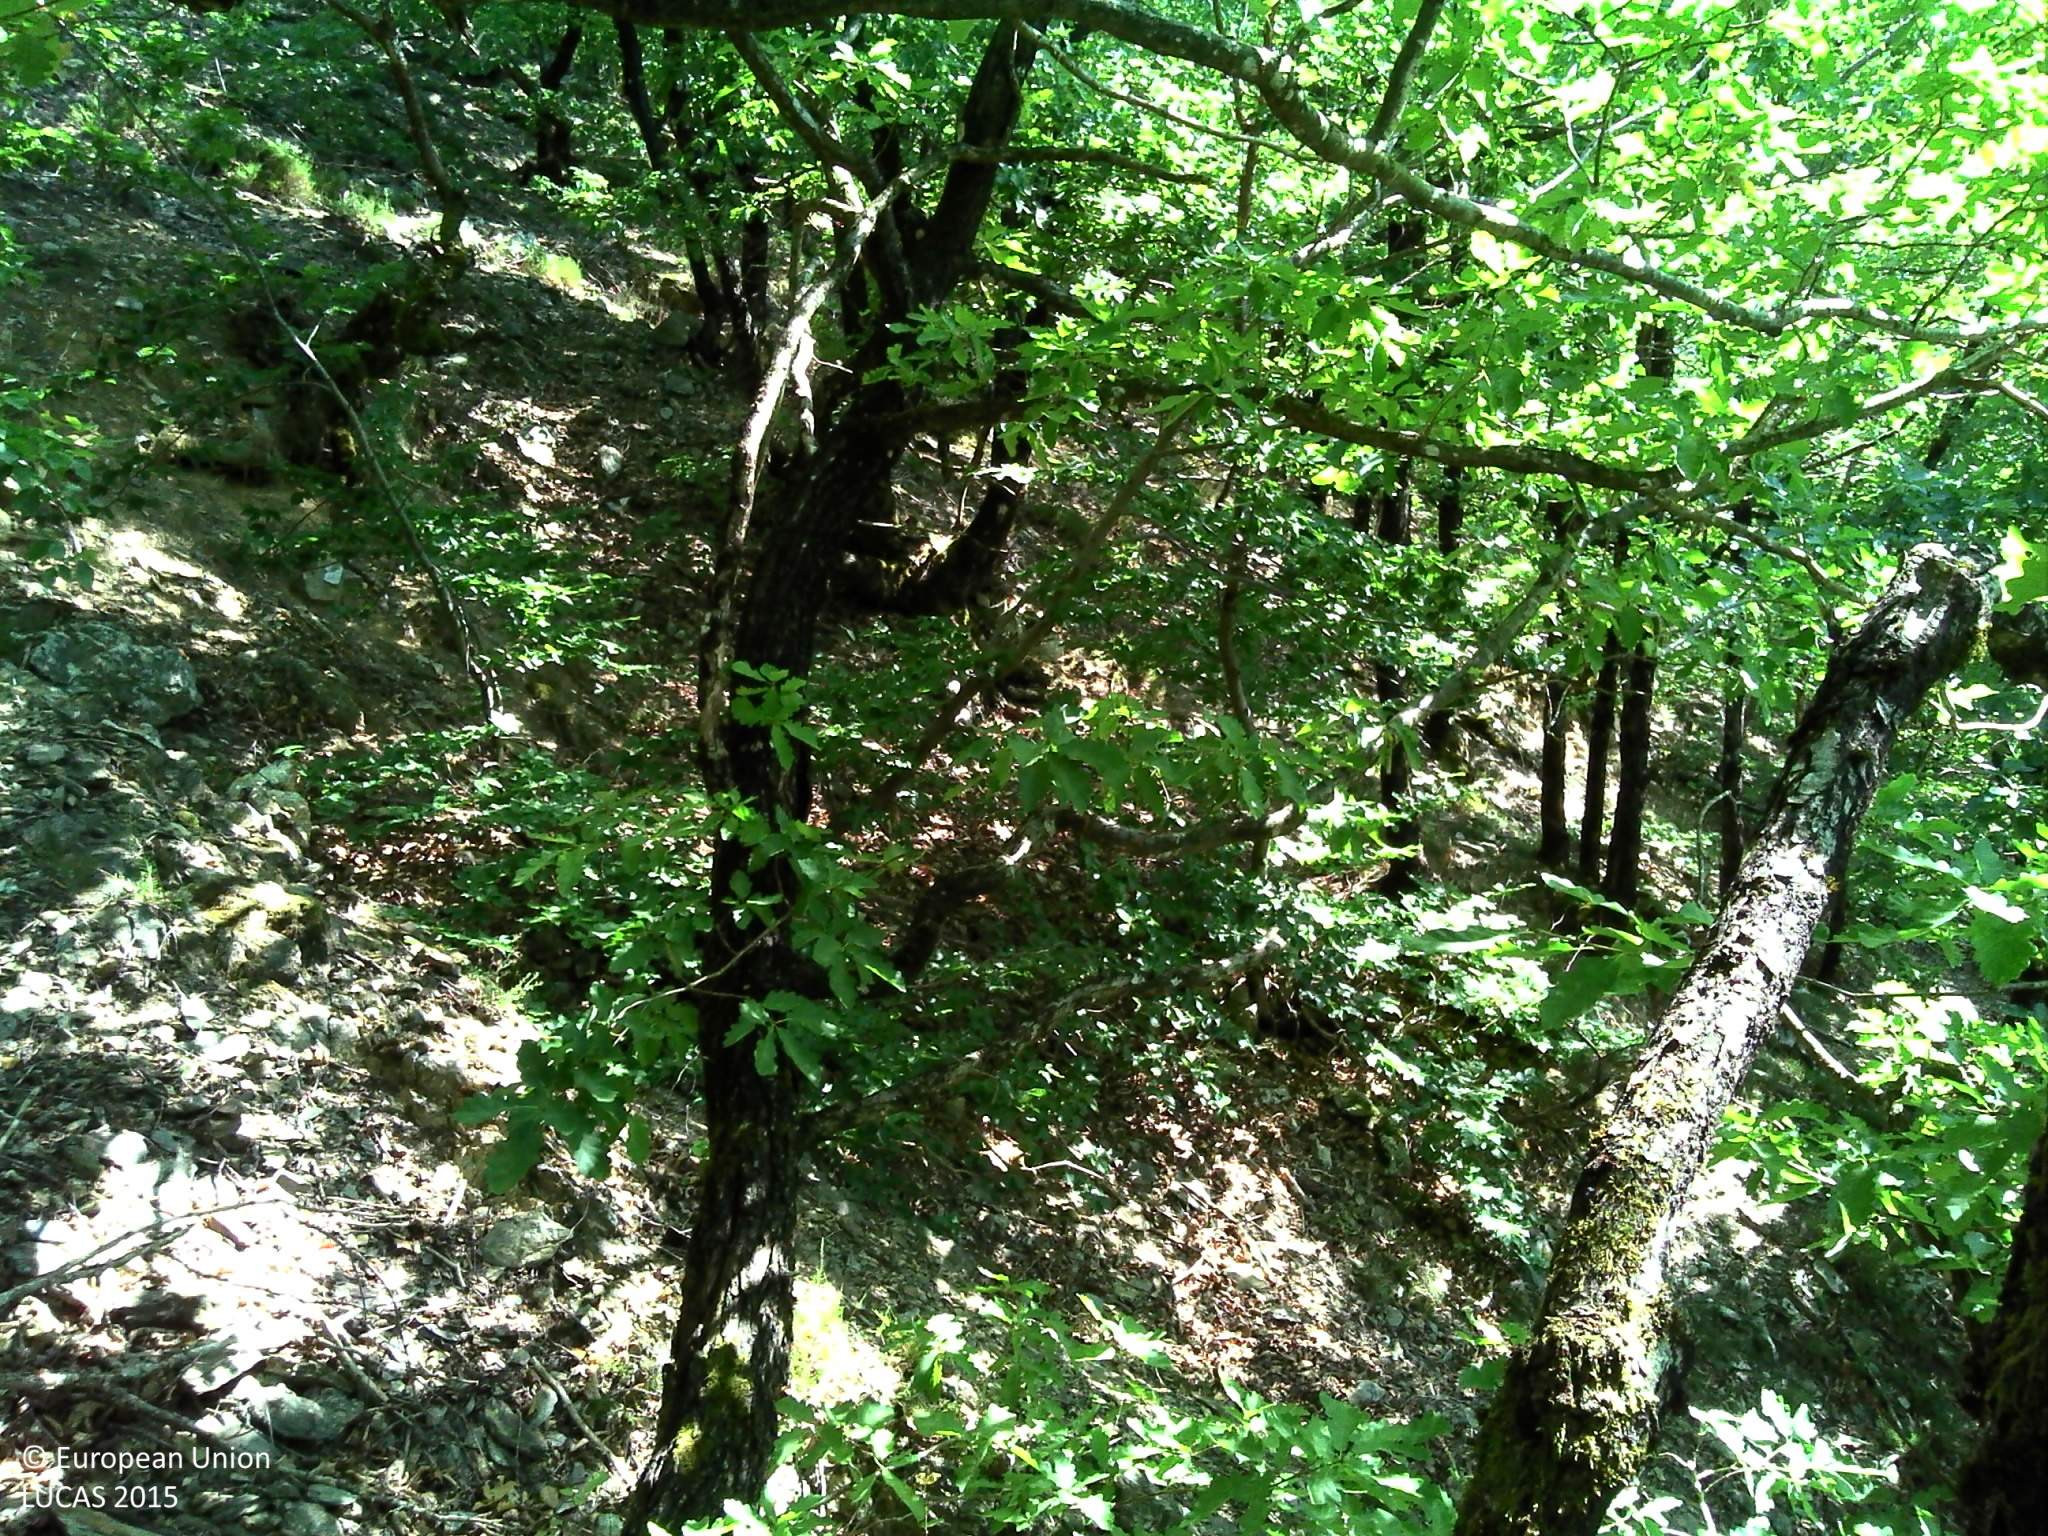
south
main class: Woodland
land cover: Broadleaved woodland
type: acidophilous oak and oak-birch forest
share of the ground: > 75 %
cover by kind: broadleaved forest trees 90 %, herbaceous plants 5 %, lichens and mosses 5 %
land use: Forestry
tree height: > 5 m
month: August
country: FR
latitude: 43.7727
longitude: 3.0376
